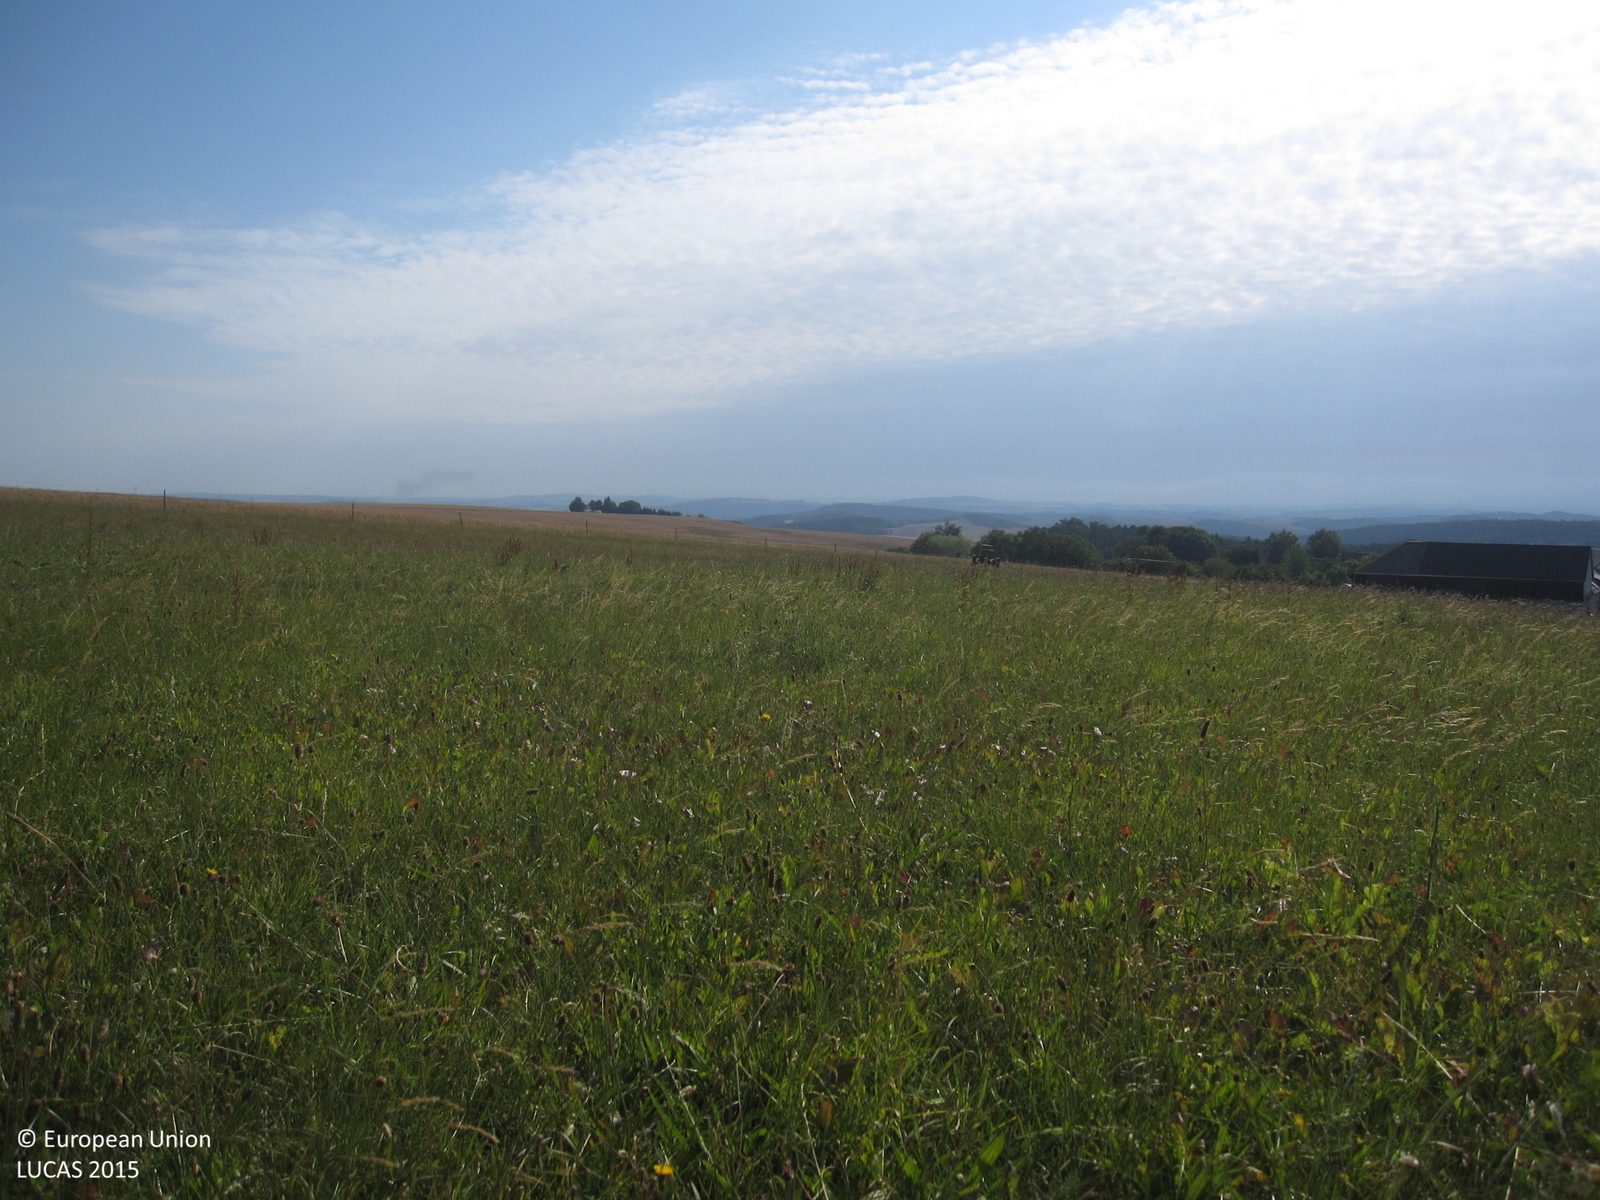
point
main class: Grassland
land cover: Grassland without tree/shrub cover
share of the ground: > 75 %
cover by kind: herbaceous plants 90 %, unconsolidated bare surface 10 %
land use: Agriculture (excluding fallow land and kitchen gardens)
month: August
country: DE
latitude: 50.5796
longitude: 12.0474
